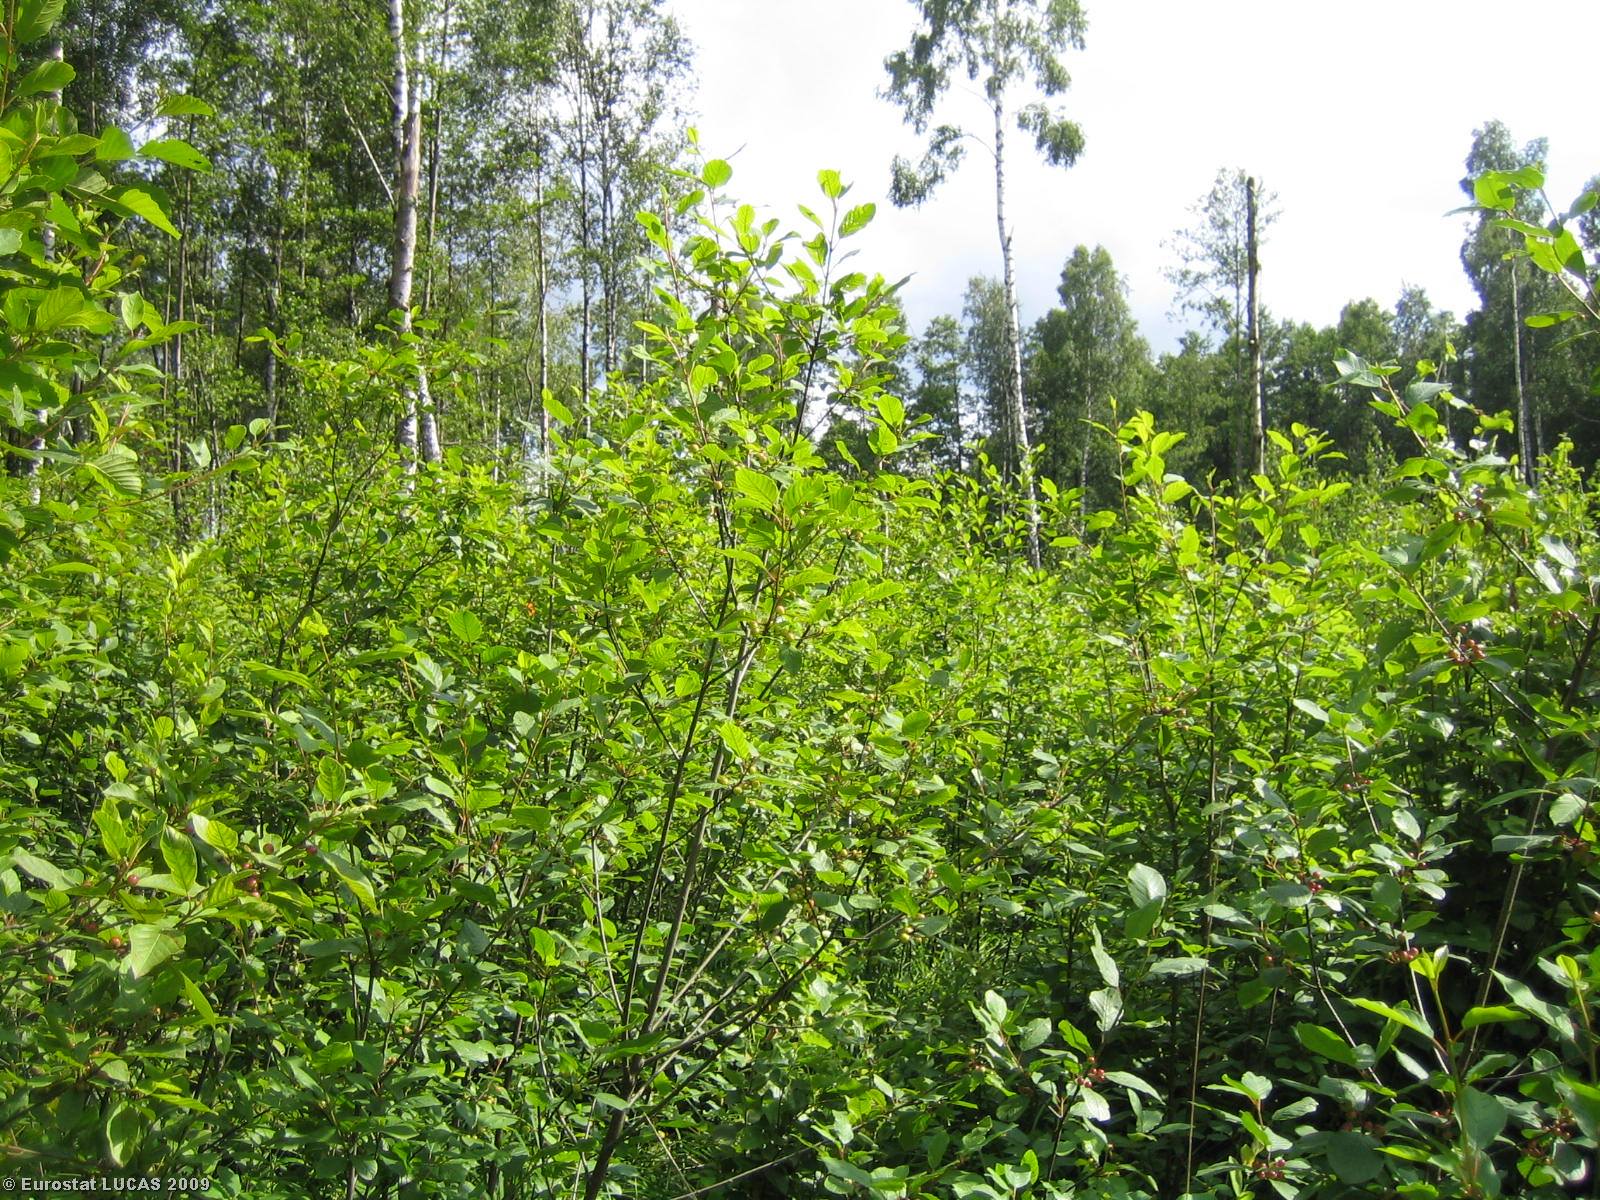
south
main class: Woodland
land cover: Broadleaved woodland
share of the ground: > 75 %
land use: Forestry
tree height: < 5 m
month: July
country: LT
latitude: 55.7762
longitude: 26.0324
